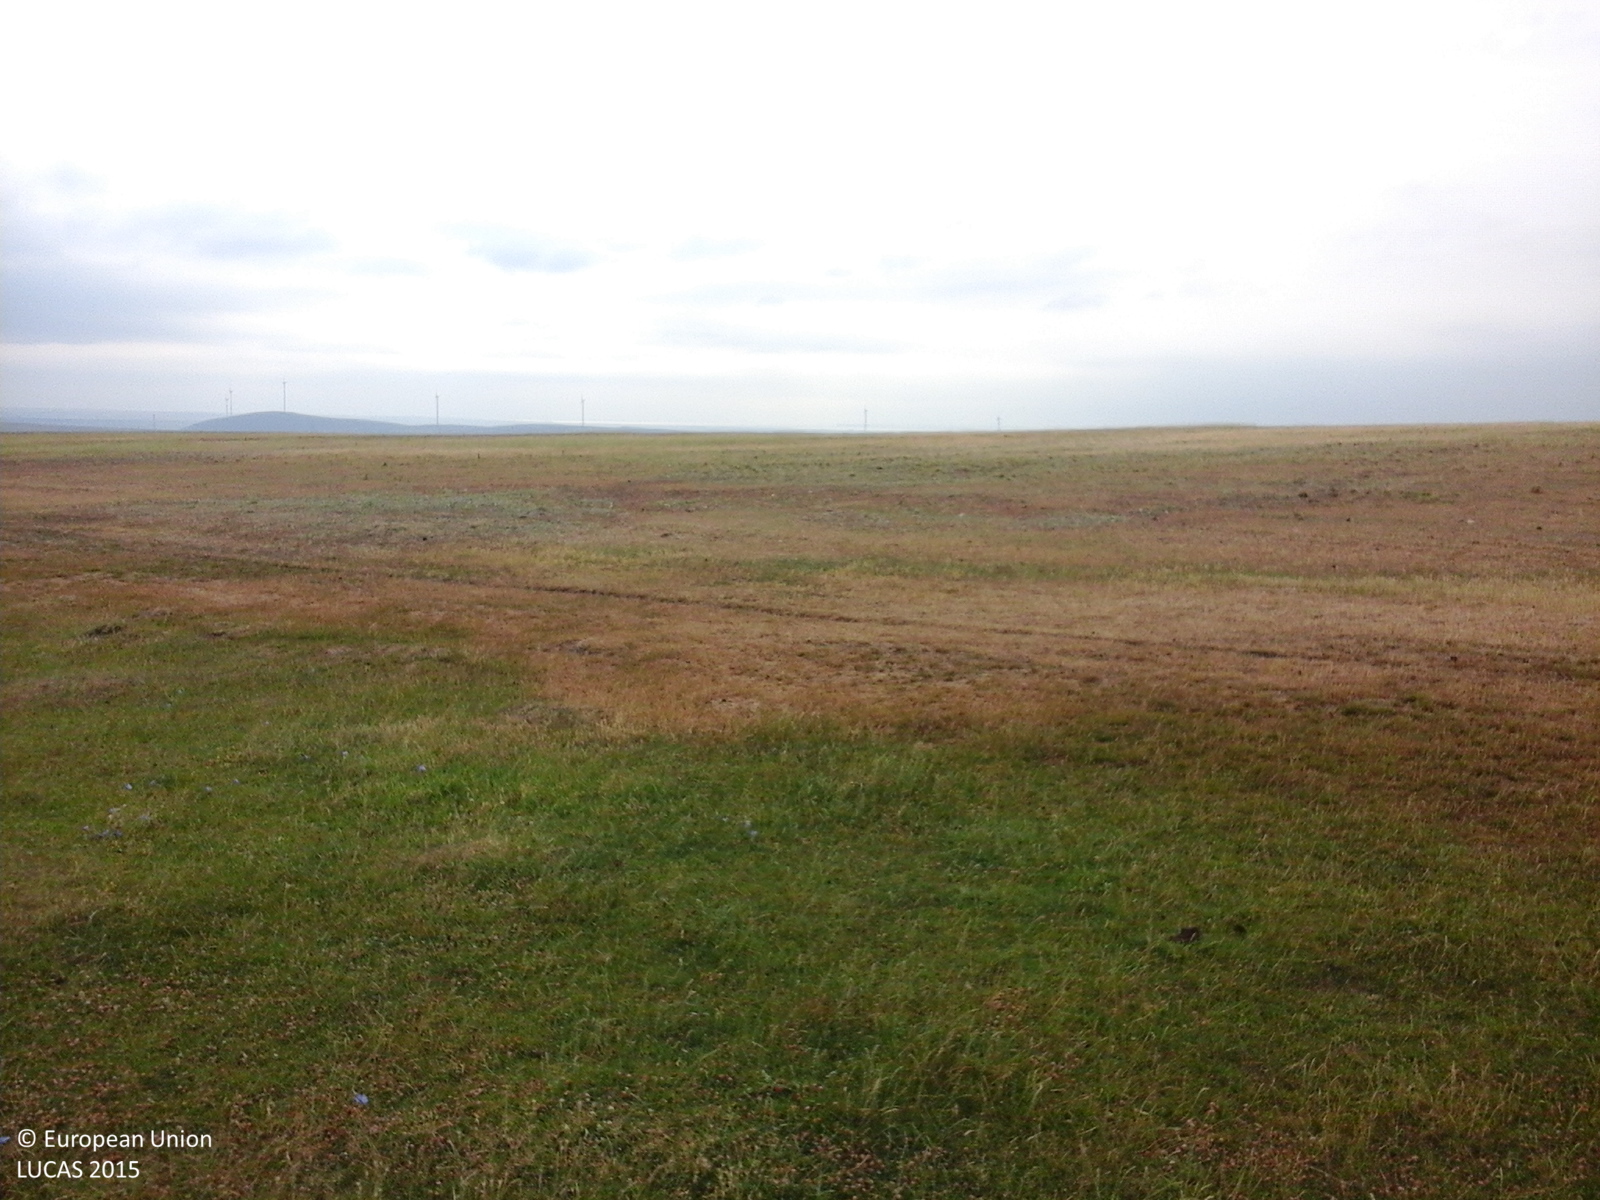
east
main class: Grassland
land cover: Grassland without tree/shrub cover
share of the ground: > 75 %
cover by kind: herbaceous plants 100 %
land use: Agriculture (excluding fallow land and kitchen gardens)
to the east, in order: Grassland without tree/shrub cover; Tracks; Grassland without tree/shrub cover
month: August
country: RO
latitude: 44.7588
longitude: 28.5859
